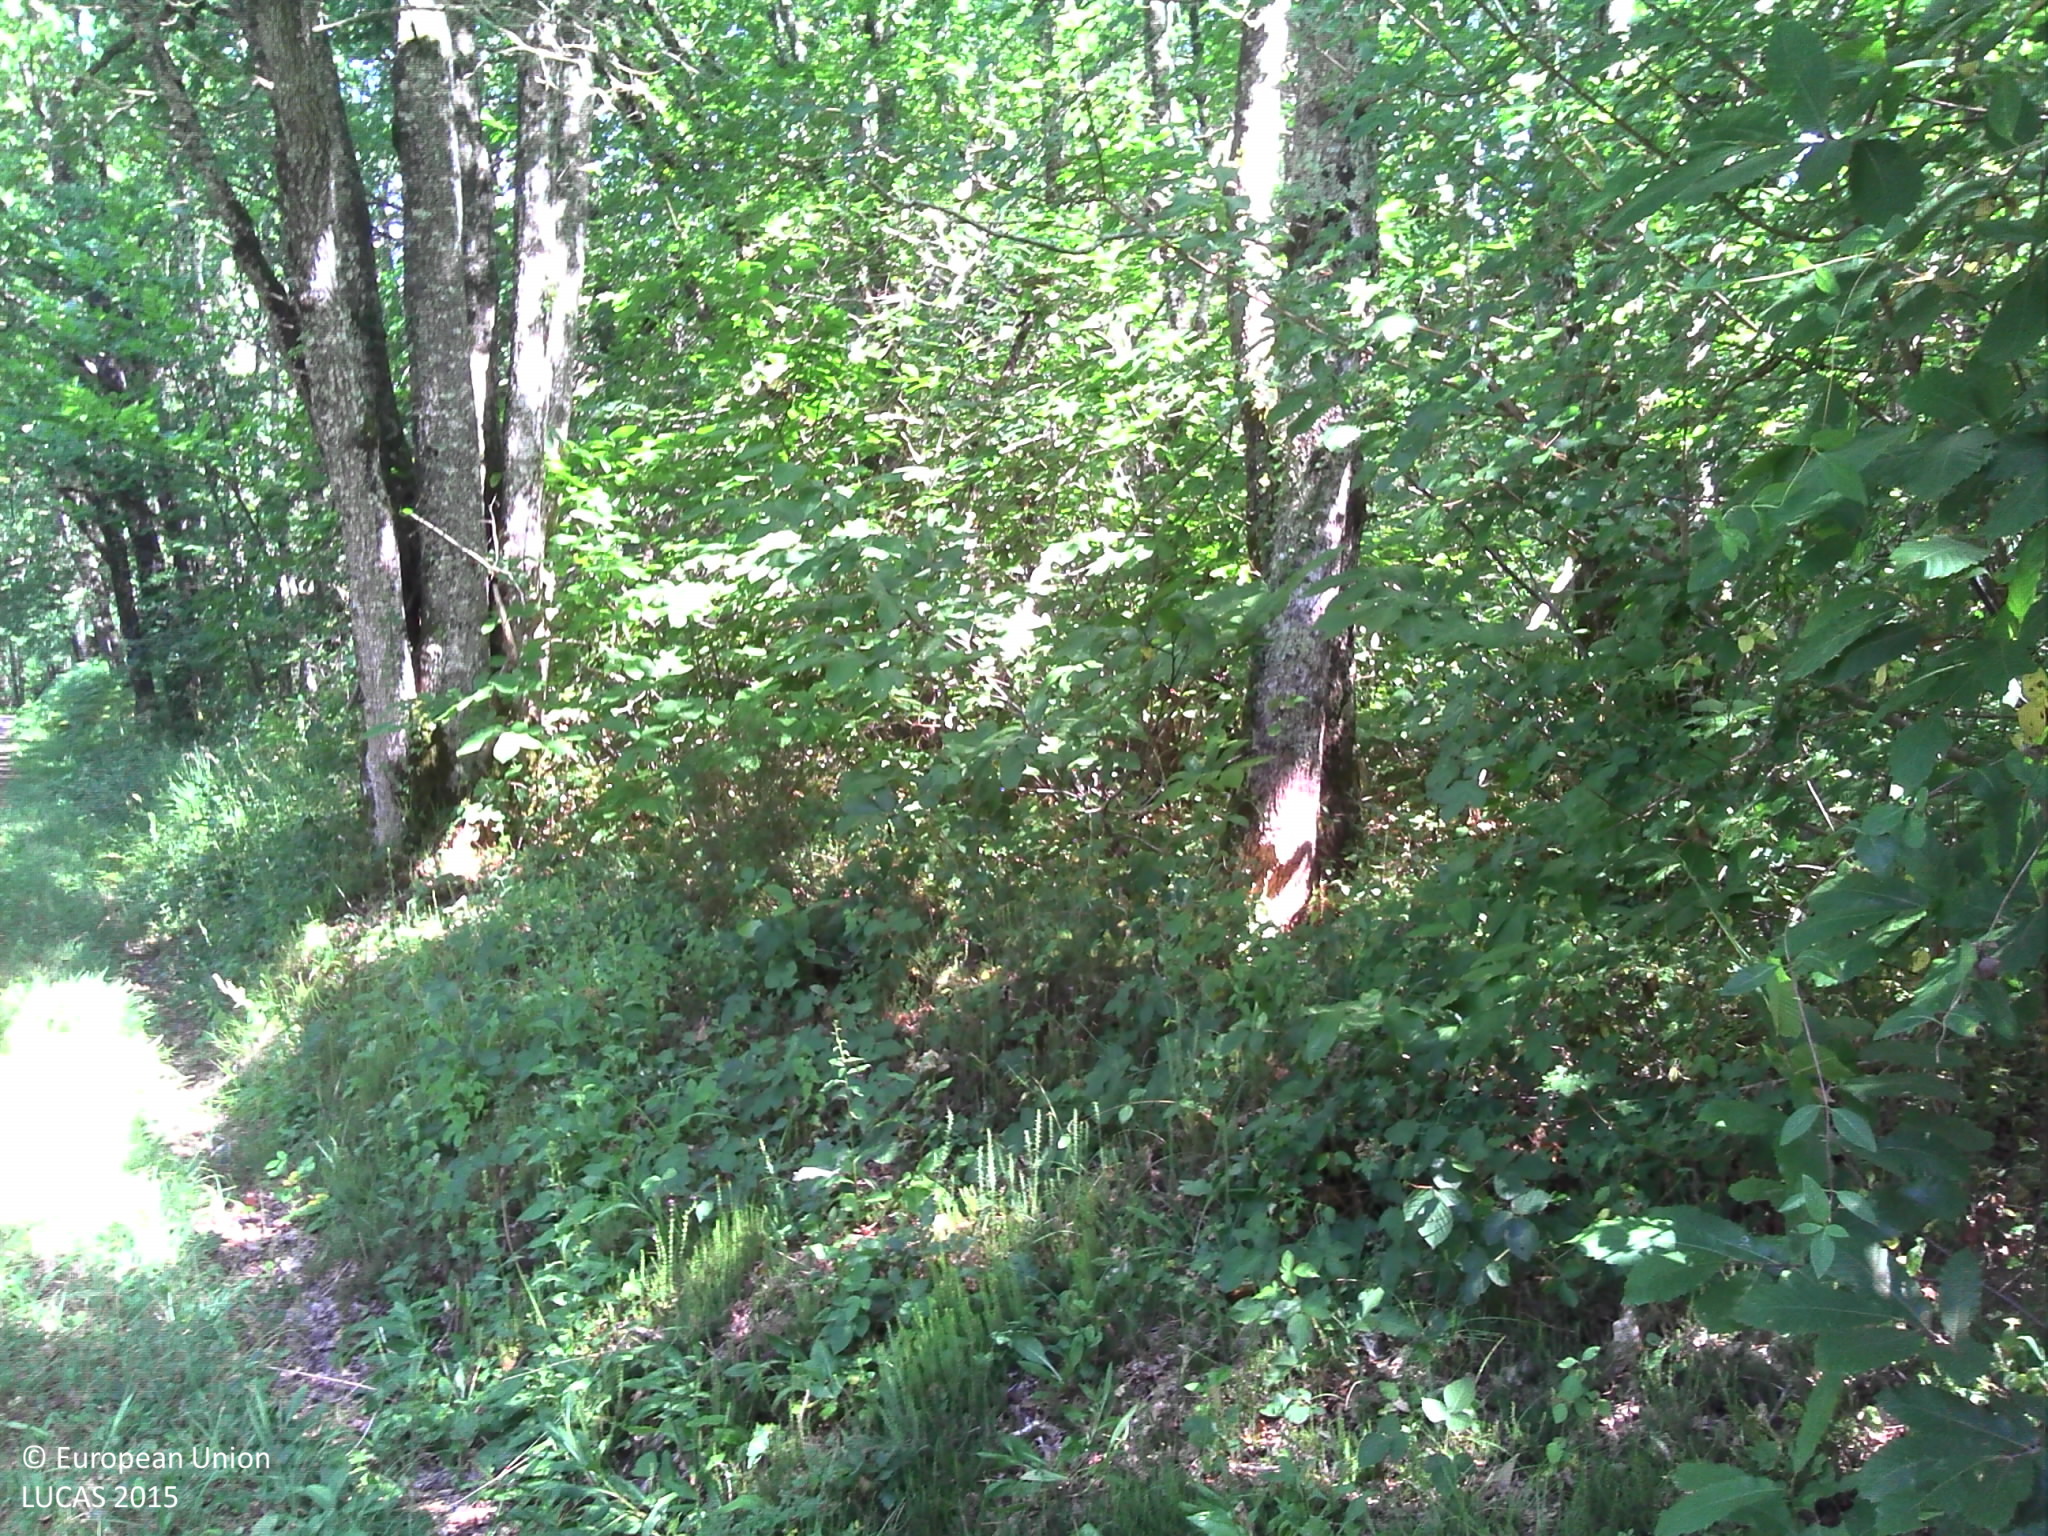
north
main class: Woodland
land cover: Broadleaved woodland
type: acidophilous oak and oak-birch forest
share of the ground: > 75 %
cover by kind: broadleaved forest trees 90 %, shrubs 5 %, herbaceous plants 5 %
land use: Forestry
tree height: > 5 m
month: July
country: FR
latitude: 46.5517
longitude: 0.1847
